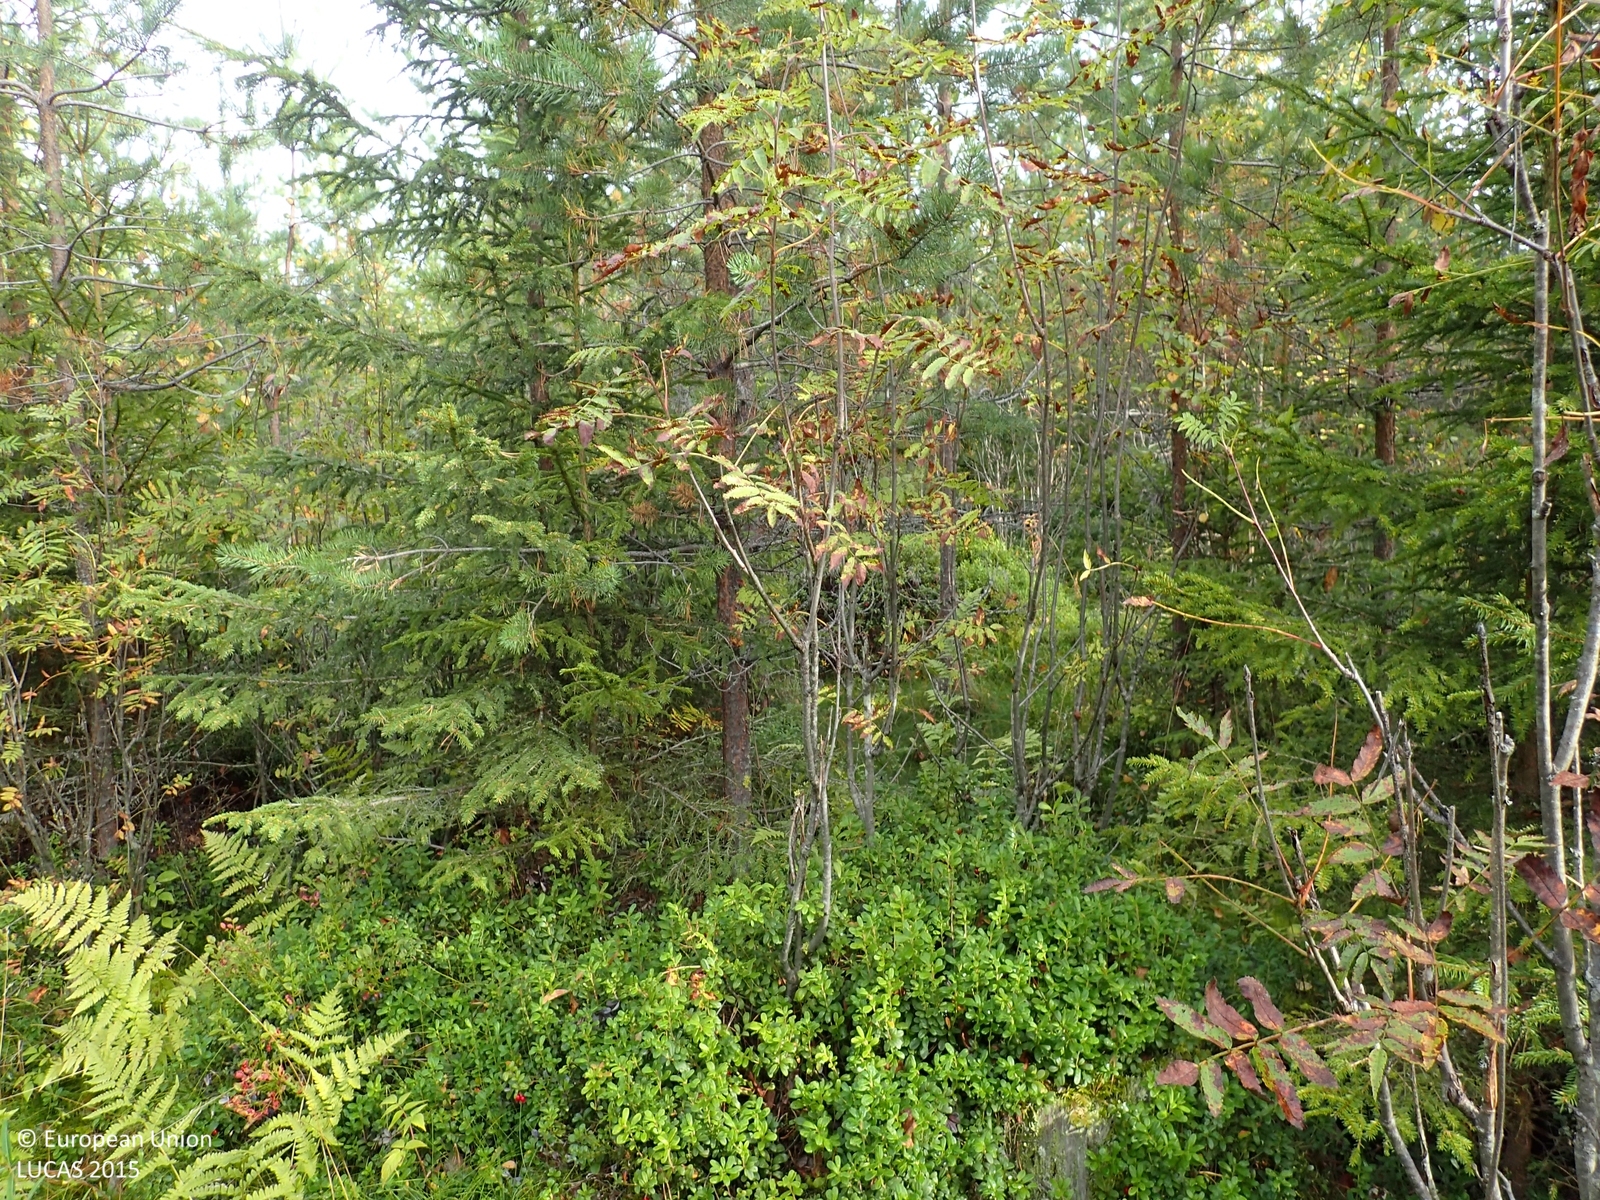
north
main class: Woodland
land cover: Pine dominated mixed woodland
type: boreal forest
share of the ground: > 75 %
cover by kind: coniferous forest trees 50 %, broadleaved forest trees 30 %, shrubs 20 %
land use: Forestry
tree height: < 5 m
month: September
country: FI
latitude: 63.1553
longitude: 25.9762
